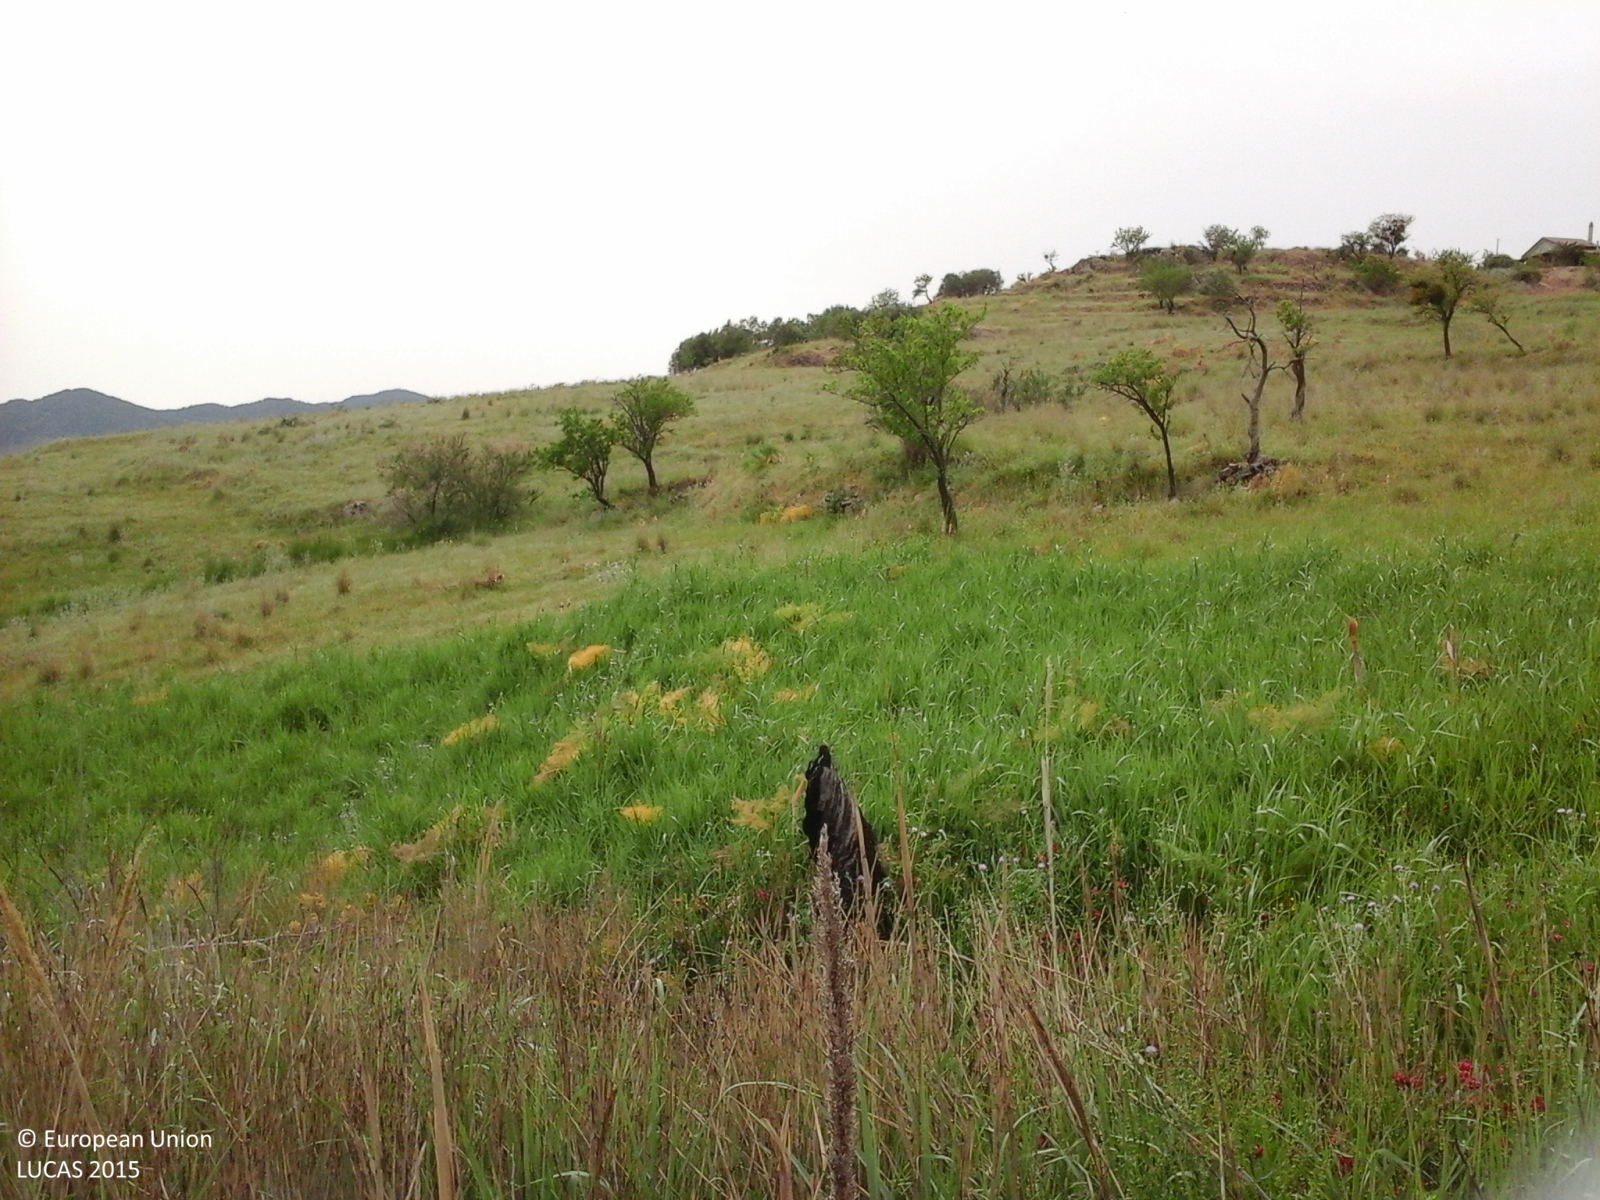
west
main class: Grassland
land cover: Spontaneously vegetated surfaces
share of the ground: > 75 %
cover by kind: herbaceous plants 100 %
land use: Agriculture (excluding fallow land and kitchen gardens)
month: May
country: IT
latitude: 37.8061
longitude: 14.8391
